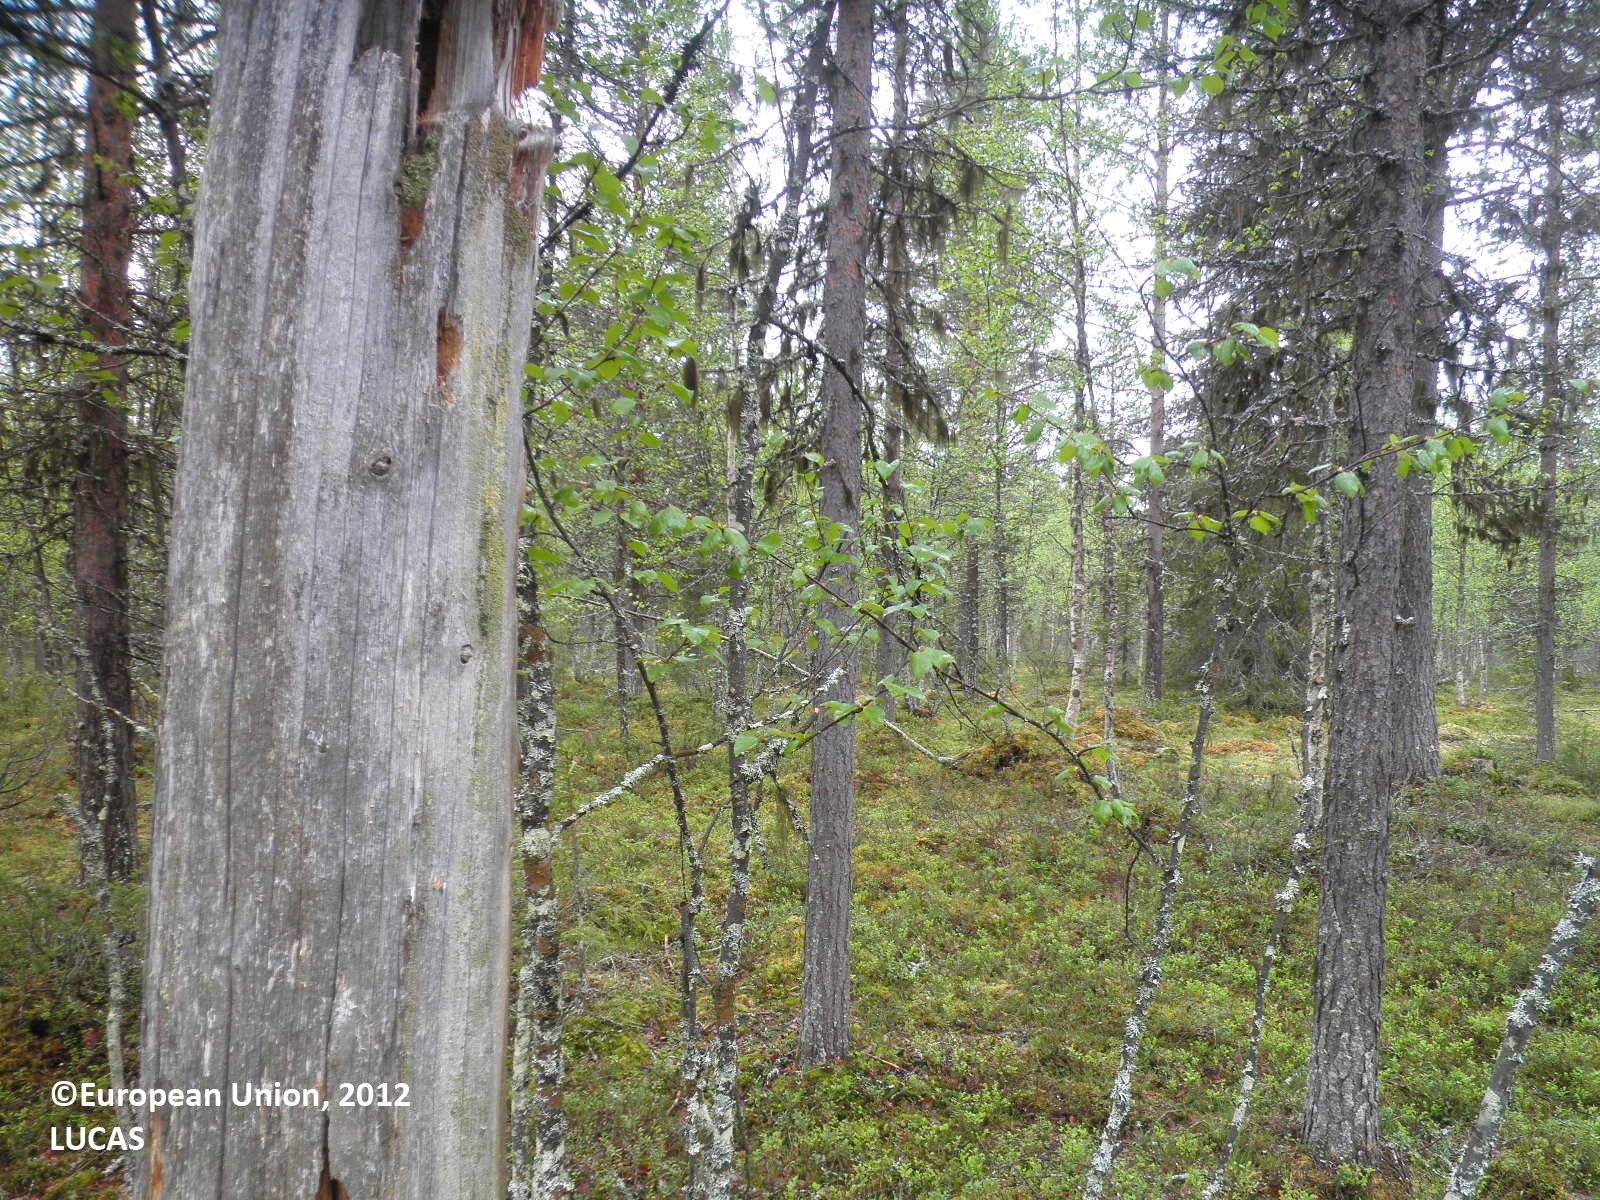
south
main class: Woodland
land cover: Pine dominated mixed woodland
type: boreal forest
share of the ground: > 75 %
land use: Forestry
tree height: > 5 m
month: June
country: FI
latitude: 68.0839
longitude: 25.4274
